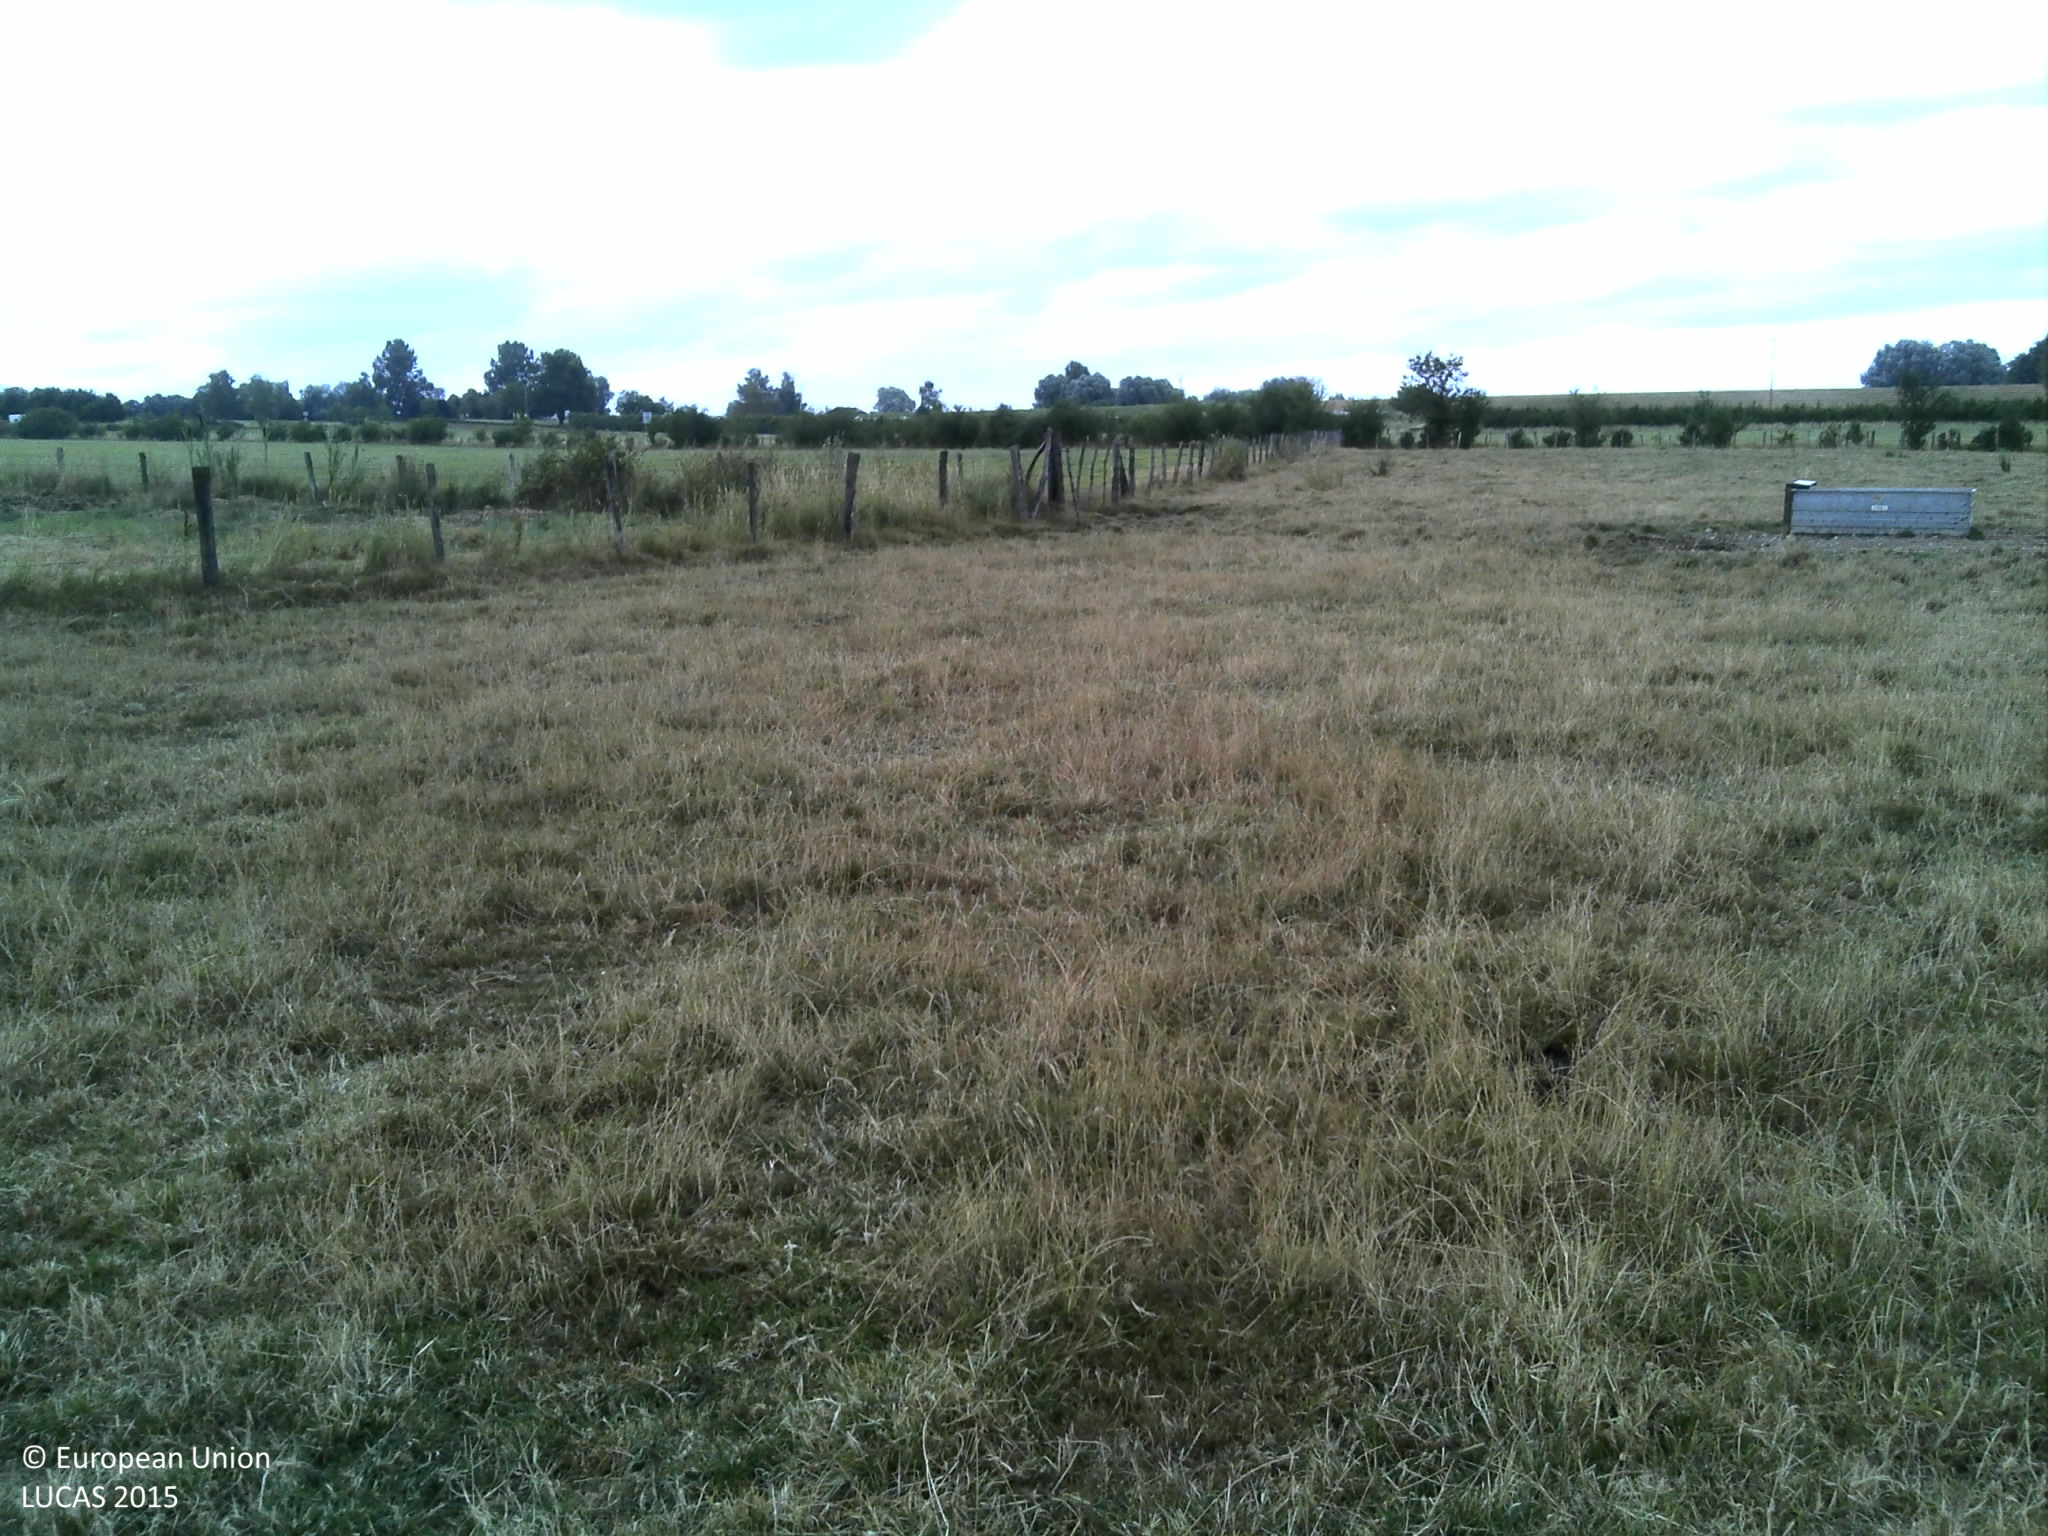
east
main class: Grassland
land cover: Grassland without tree/shrub cover
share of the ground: > 75 %
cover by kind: herbaceous plants 100 %
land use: Agriculture (excluding fallow land and kitchen gardens)
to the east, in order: Grassland without tree/shrub cover; Fences; Abandoned hedges; Fences; Grassland without tree/shrub cover; Lines of trees; Grassland without tree/shrub cover; Fences; Grass margins; Paved roads, cycling and walking lanes; Grass margins; Abandoned hedges; Grass margins
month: July
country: FR
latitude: 48.5649
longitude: 4.6992
